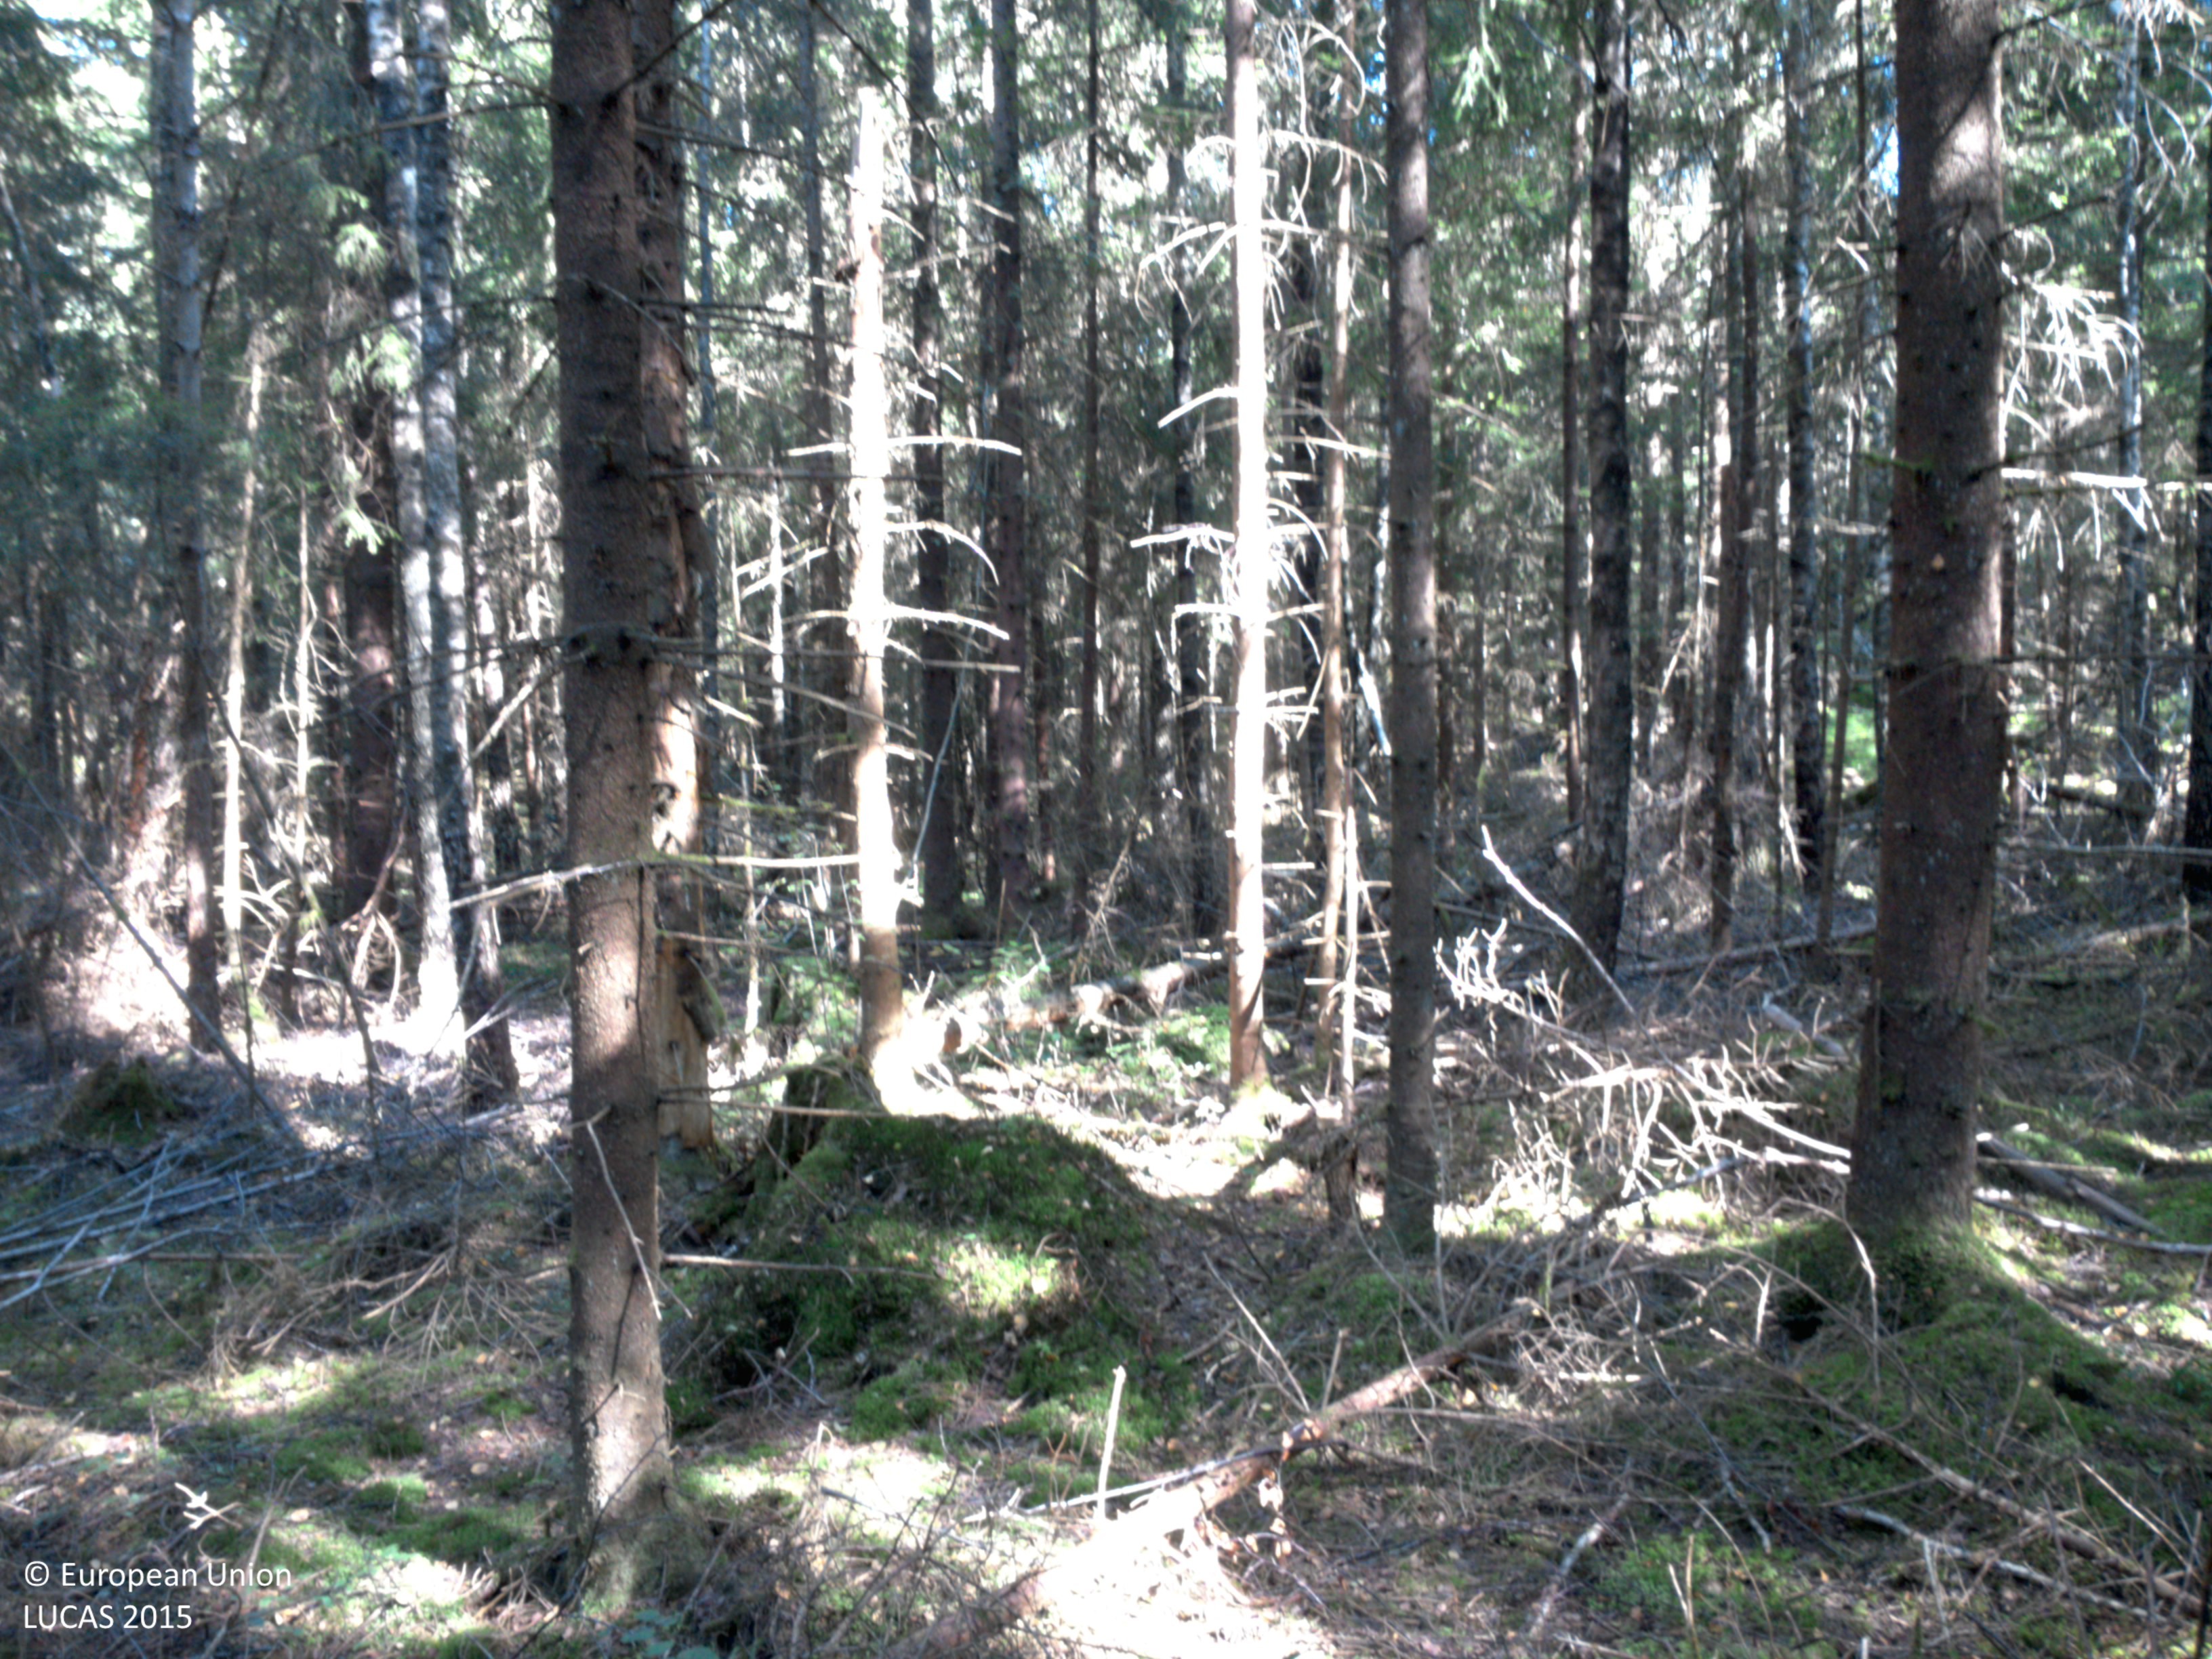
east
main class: Woodland
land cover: Spruce dominated mixed woodland
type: boreal forest
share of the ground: > 75 %
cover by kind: coniferous forest trees 60 %, broadleaved forest trees 20 %, lichens and mosses 20 %
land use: Forestry
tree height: > 5 m
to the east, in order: Spruce dominated mixed woodland
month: August
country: SE
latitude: 58.2191
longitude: 12.2259
